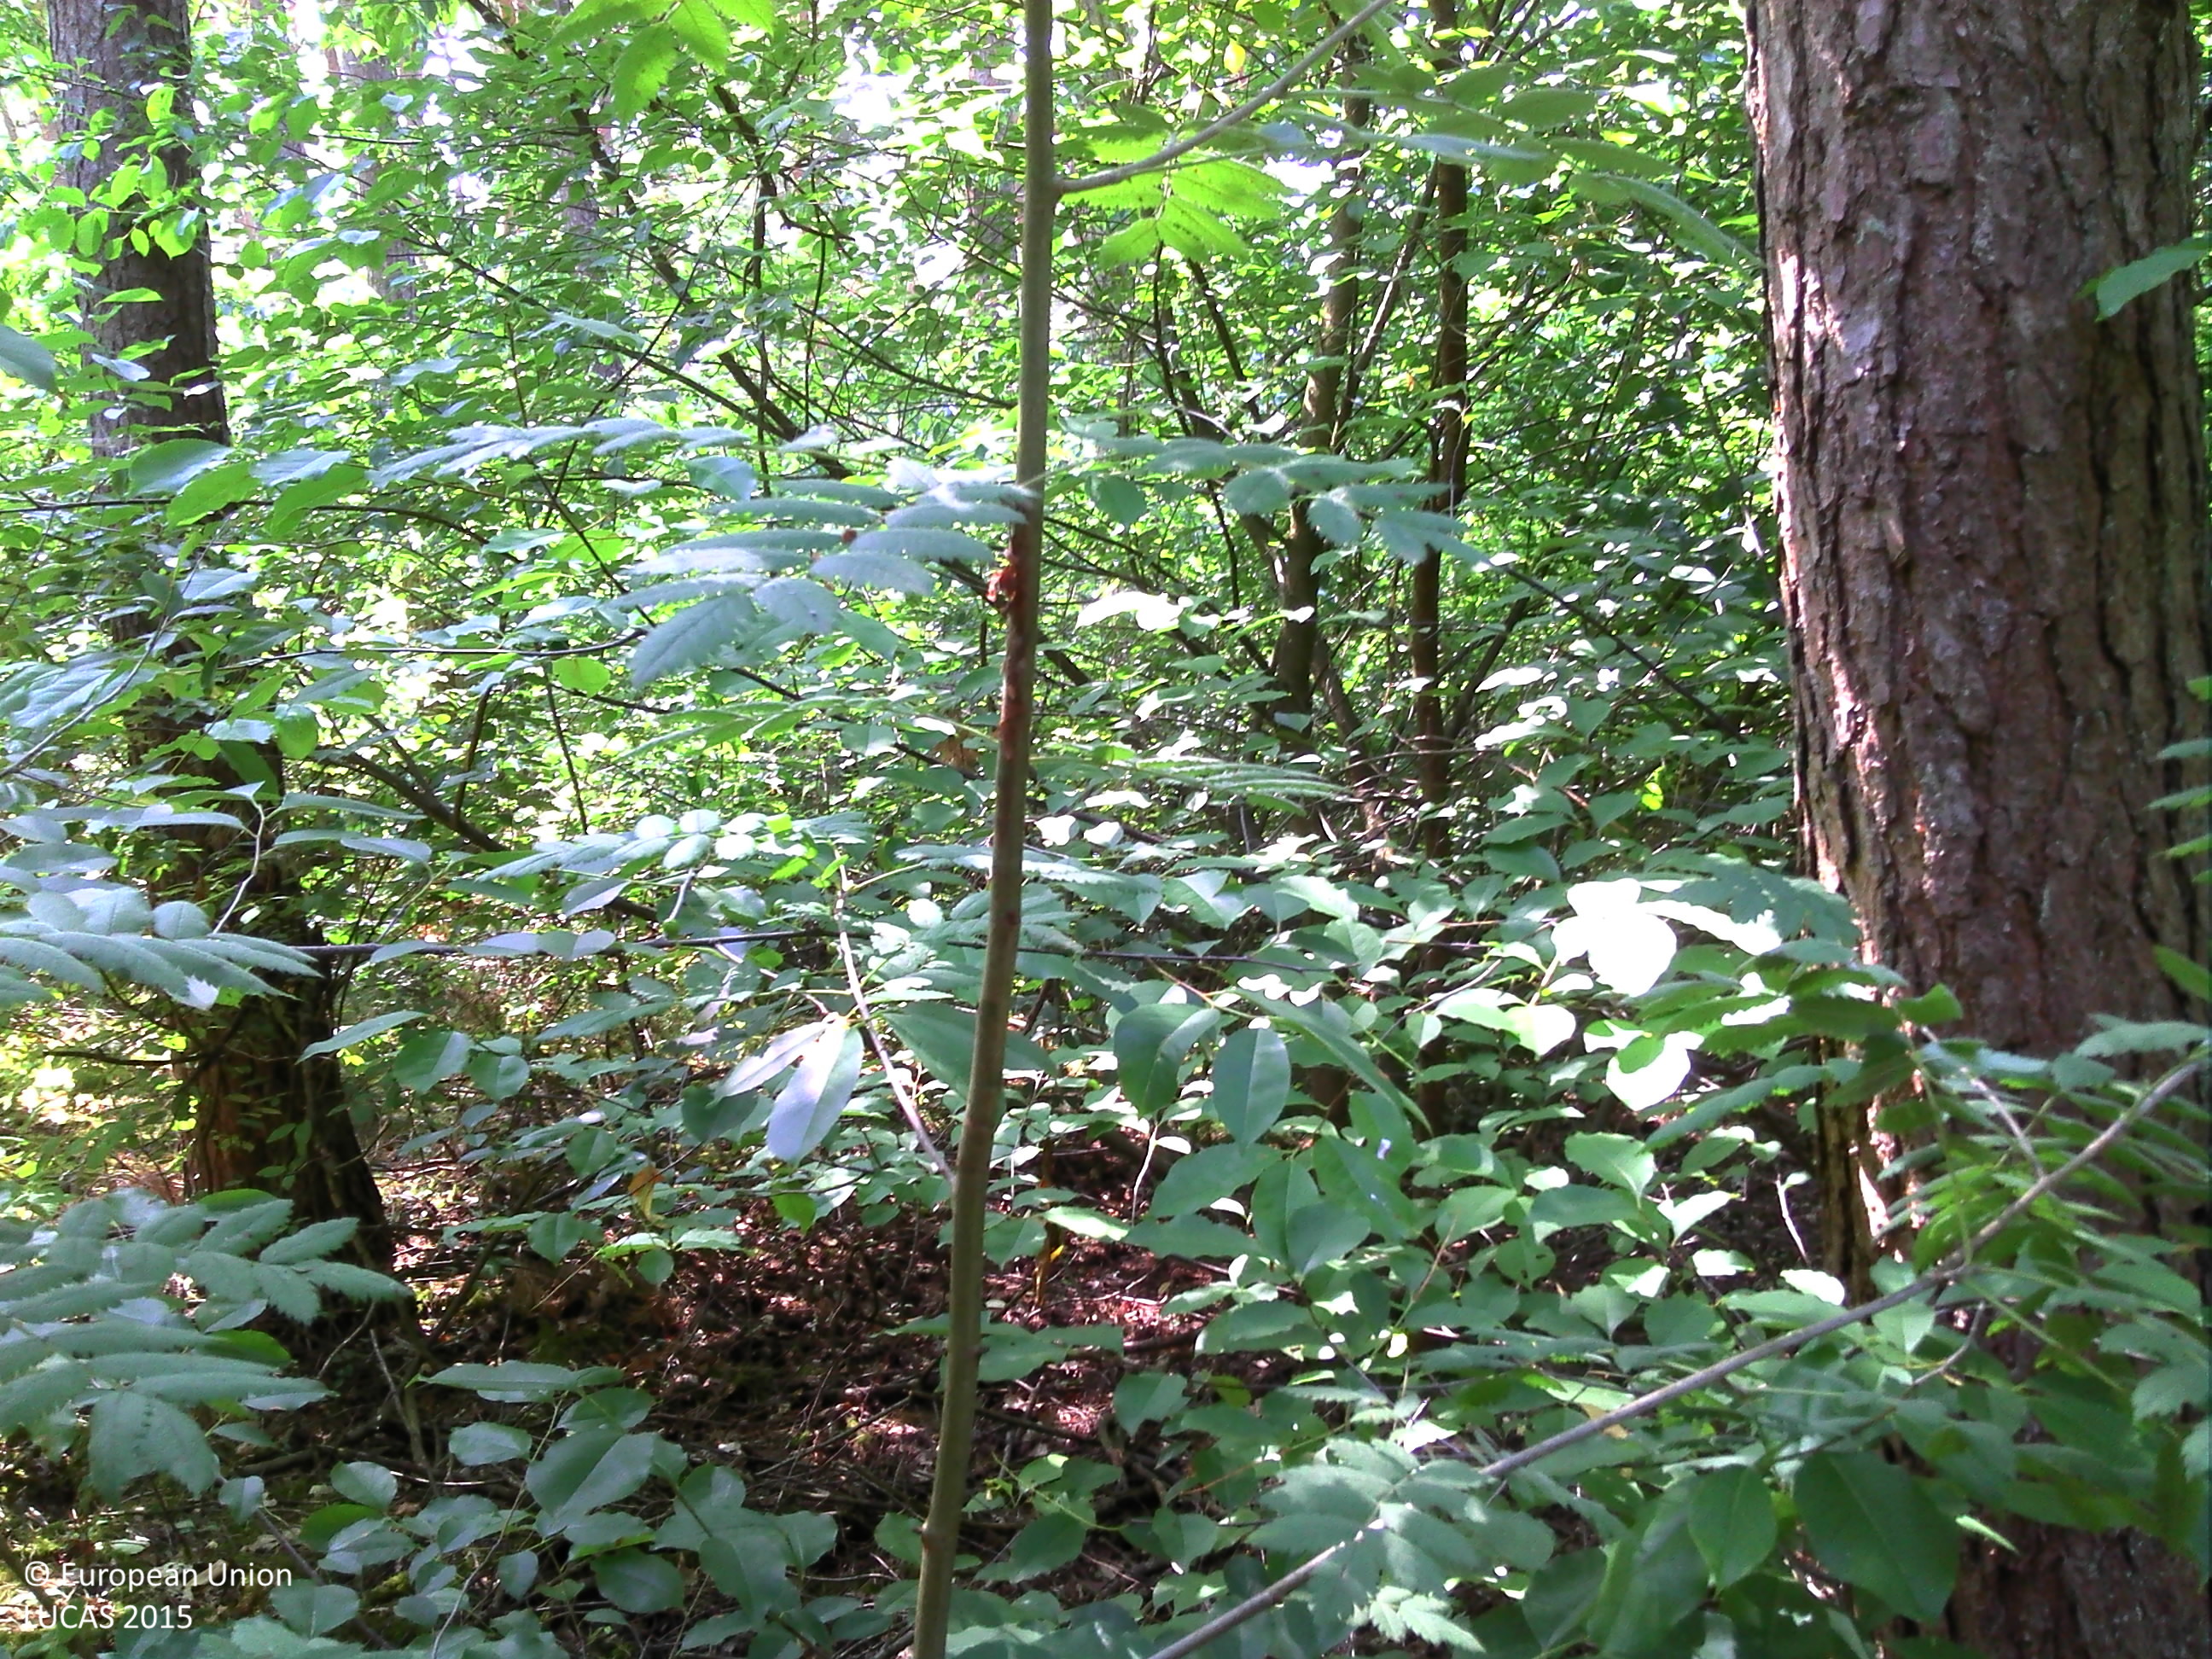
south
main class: Woodland
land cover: Pine dominated mixed woodland
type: exotic forest
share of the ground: > 75 %
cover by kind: coniferous forest trees 70 %, broadleaved forest trees 25 %, herbaceous plants 5 %
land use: Forestry
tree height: > 5 m
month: July
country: BE
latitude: 51.1723
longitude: 5.4067
